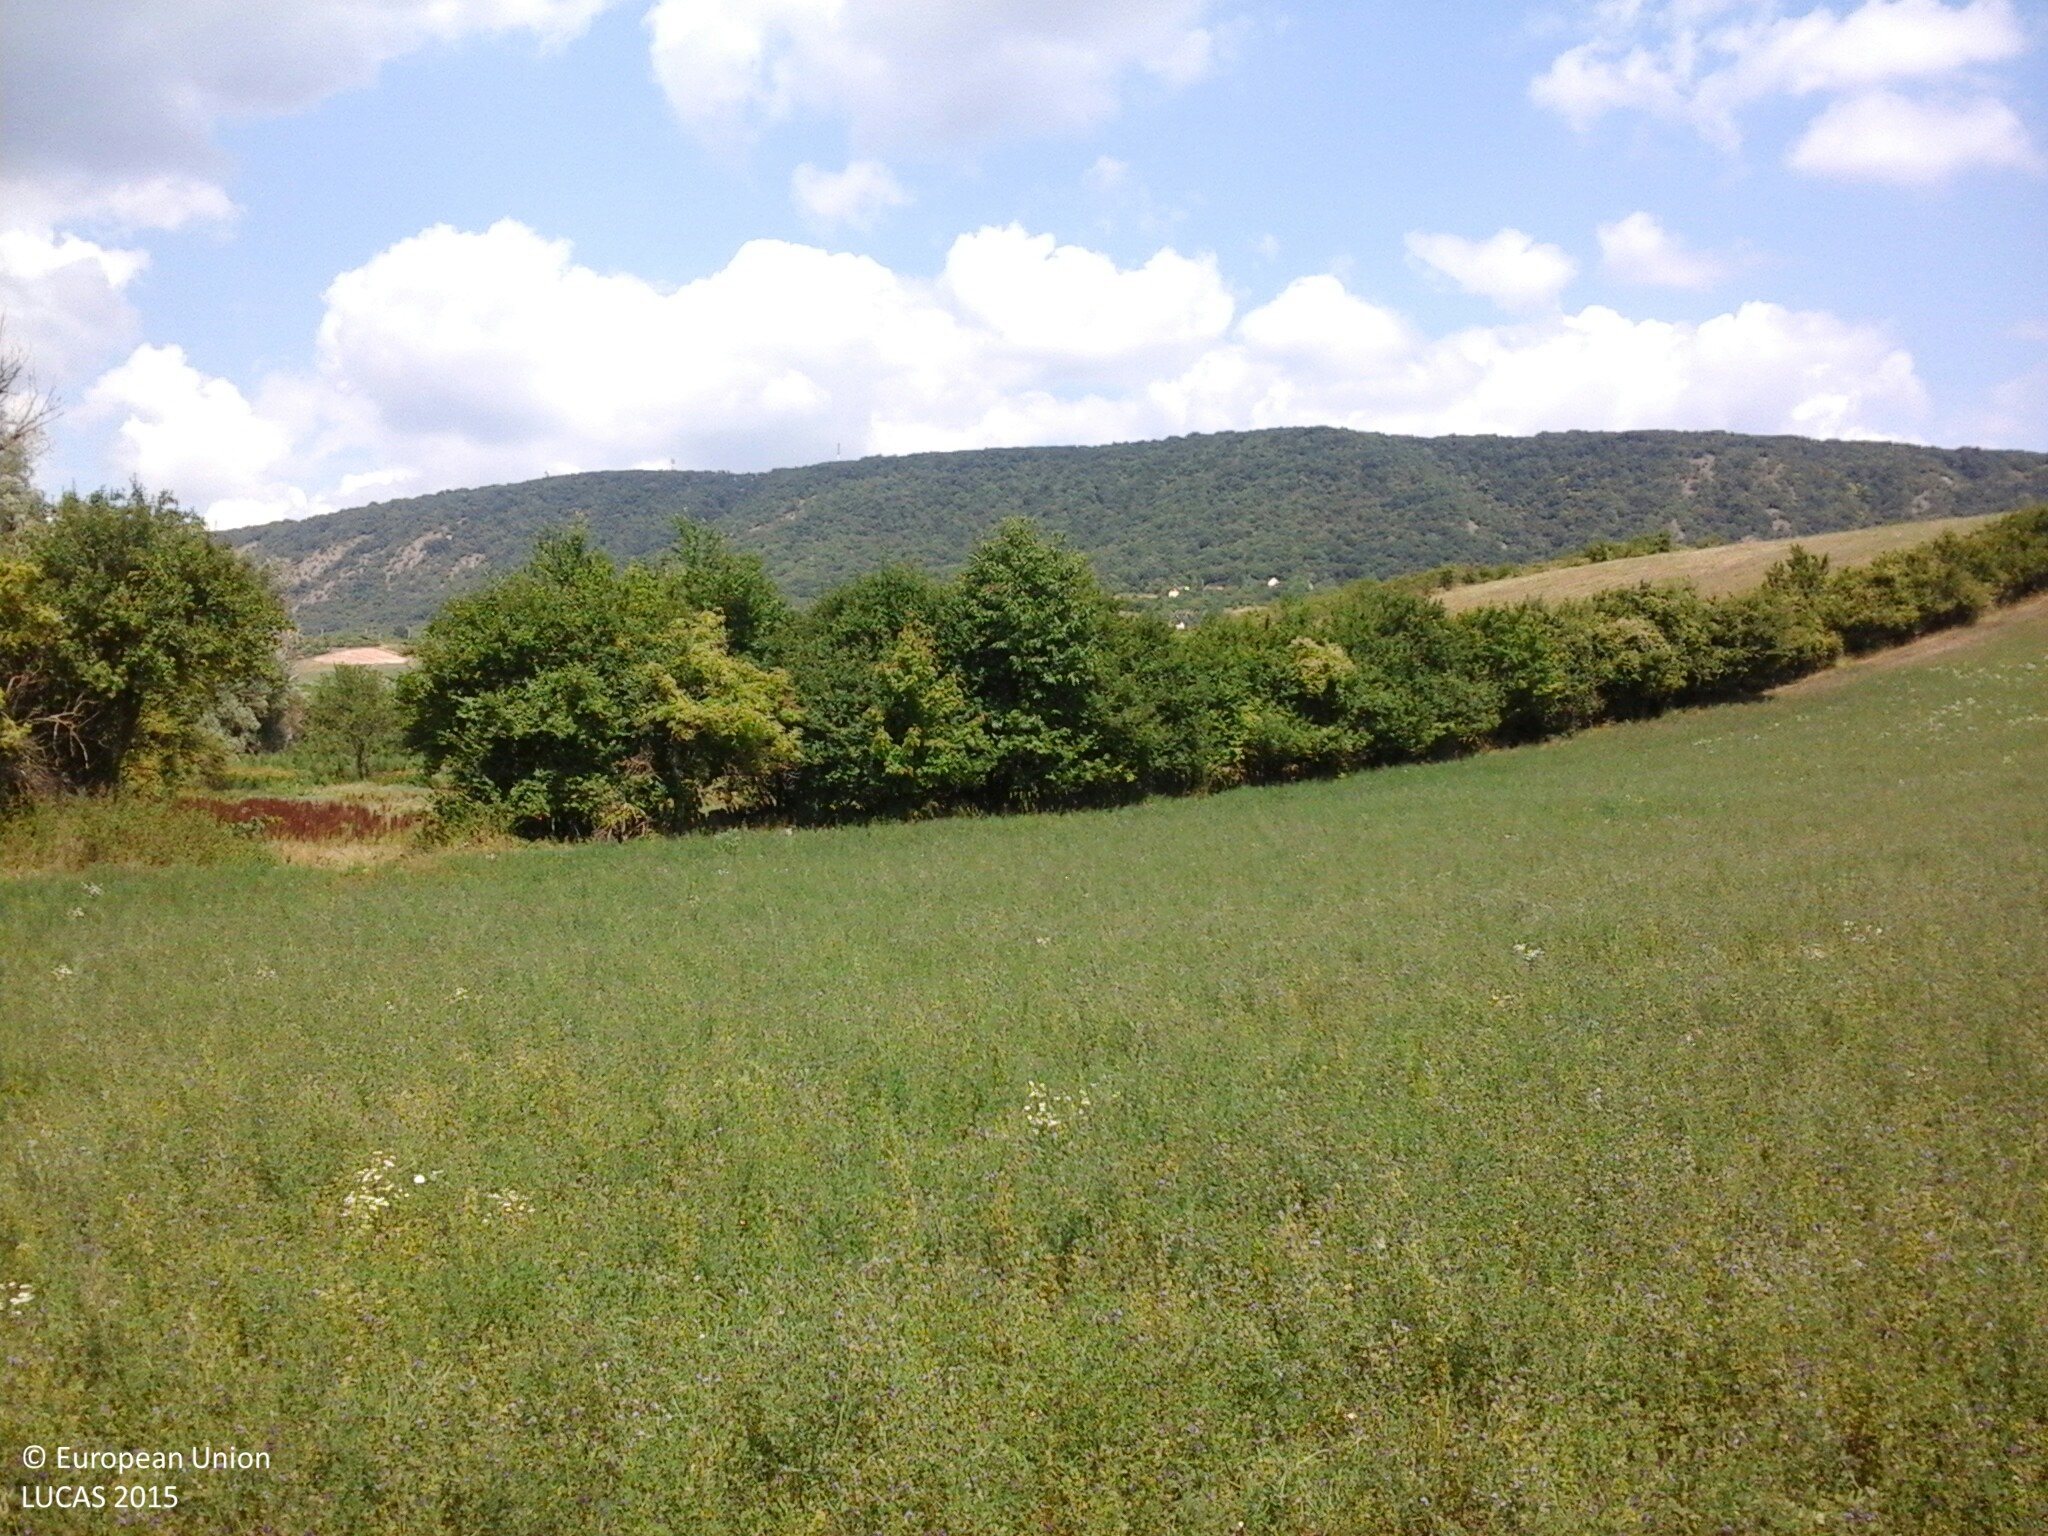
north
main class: Cropland
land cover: Lucerne
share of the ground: > 75 %
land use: Agriculture (excluding fallow land and kitchen gardens)
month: August
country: HU
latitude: 47.3525
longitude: 18.2593
